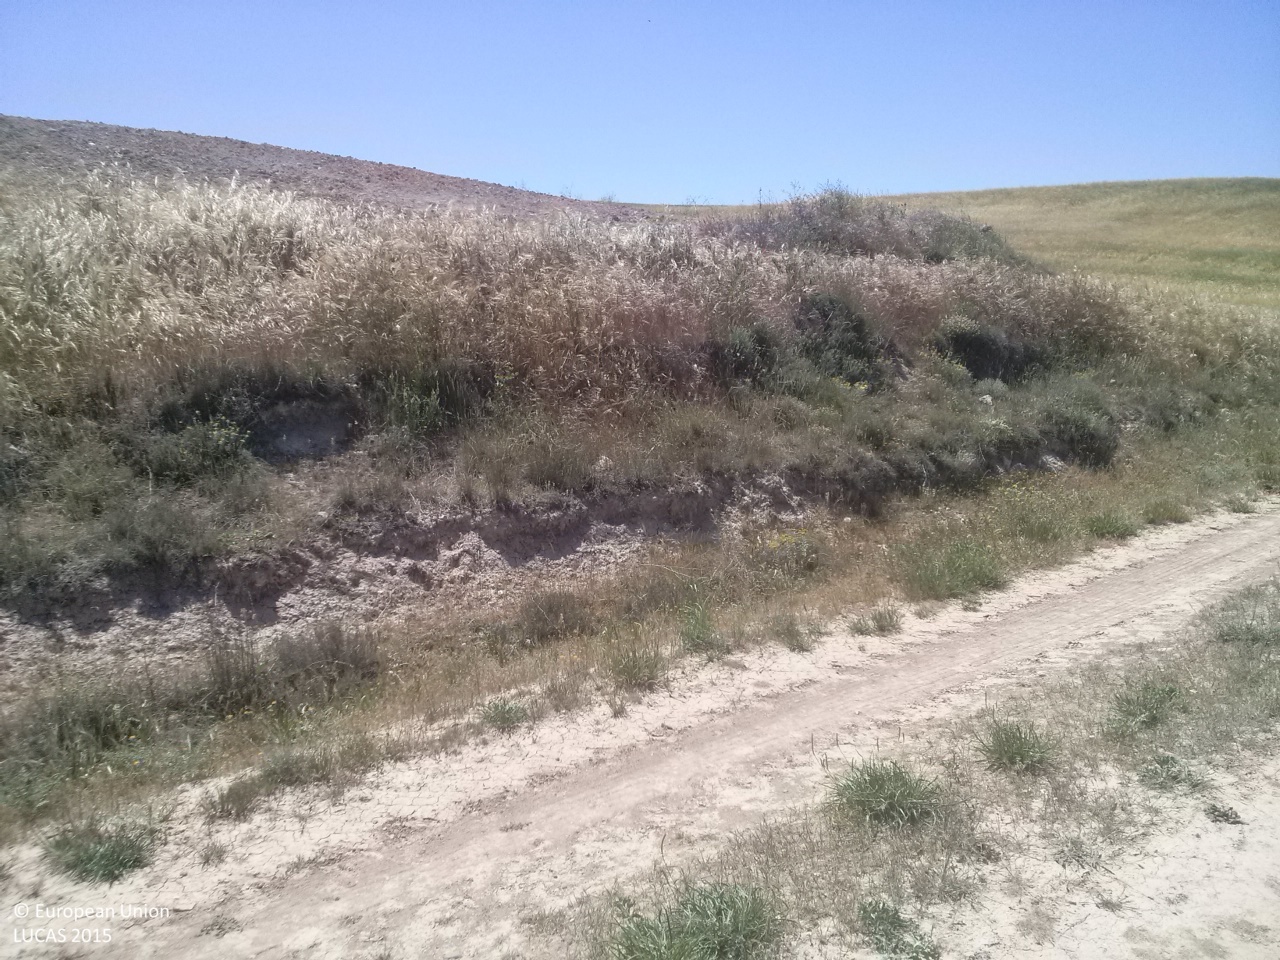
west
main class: Cropland
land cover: Barley
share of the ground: > 75 %
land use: Agriculture (excluding fallow land and kitchen gardens)
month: May
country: ES
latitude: 40.2929
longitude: -2.5983
